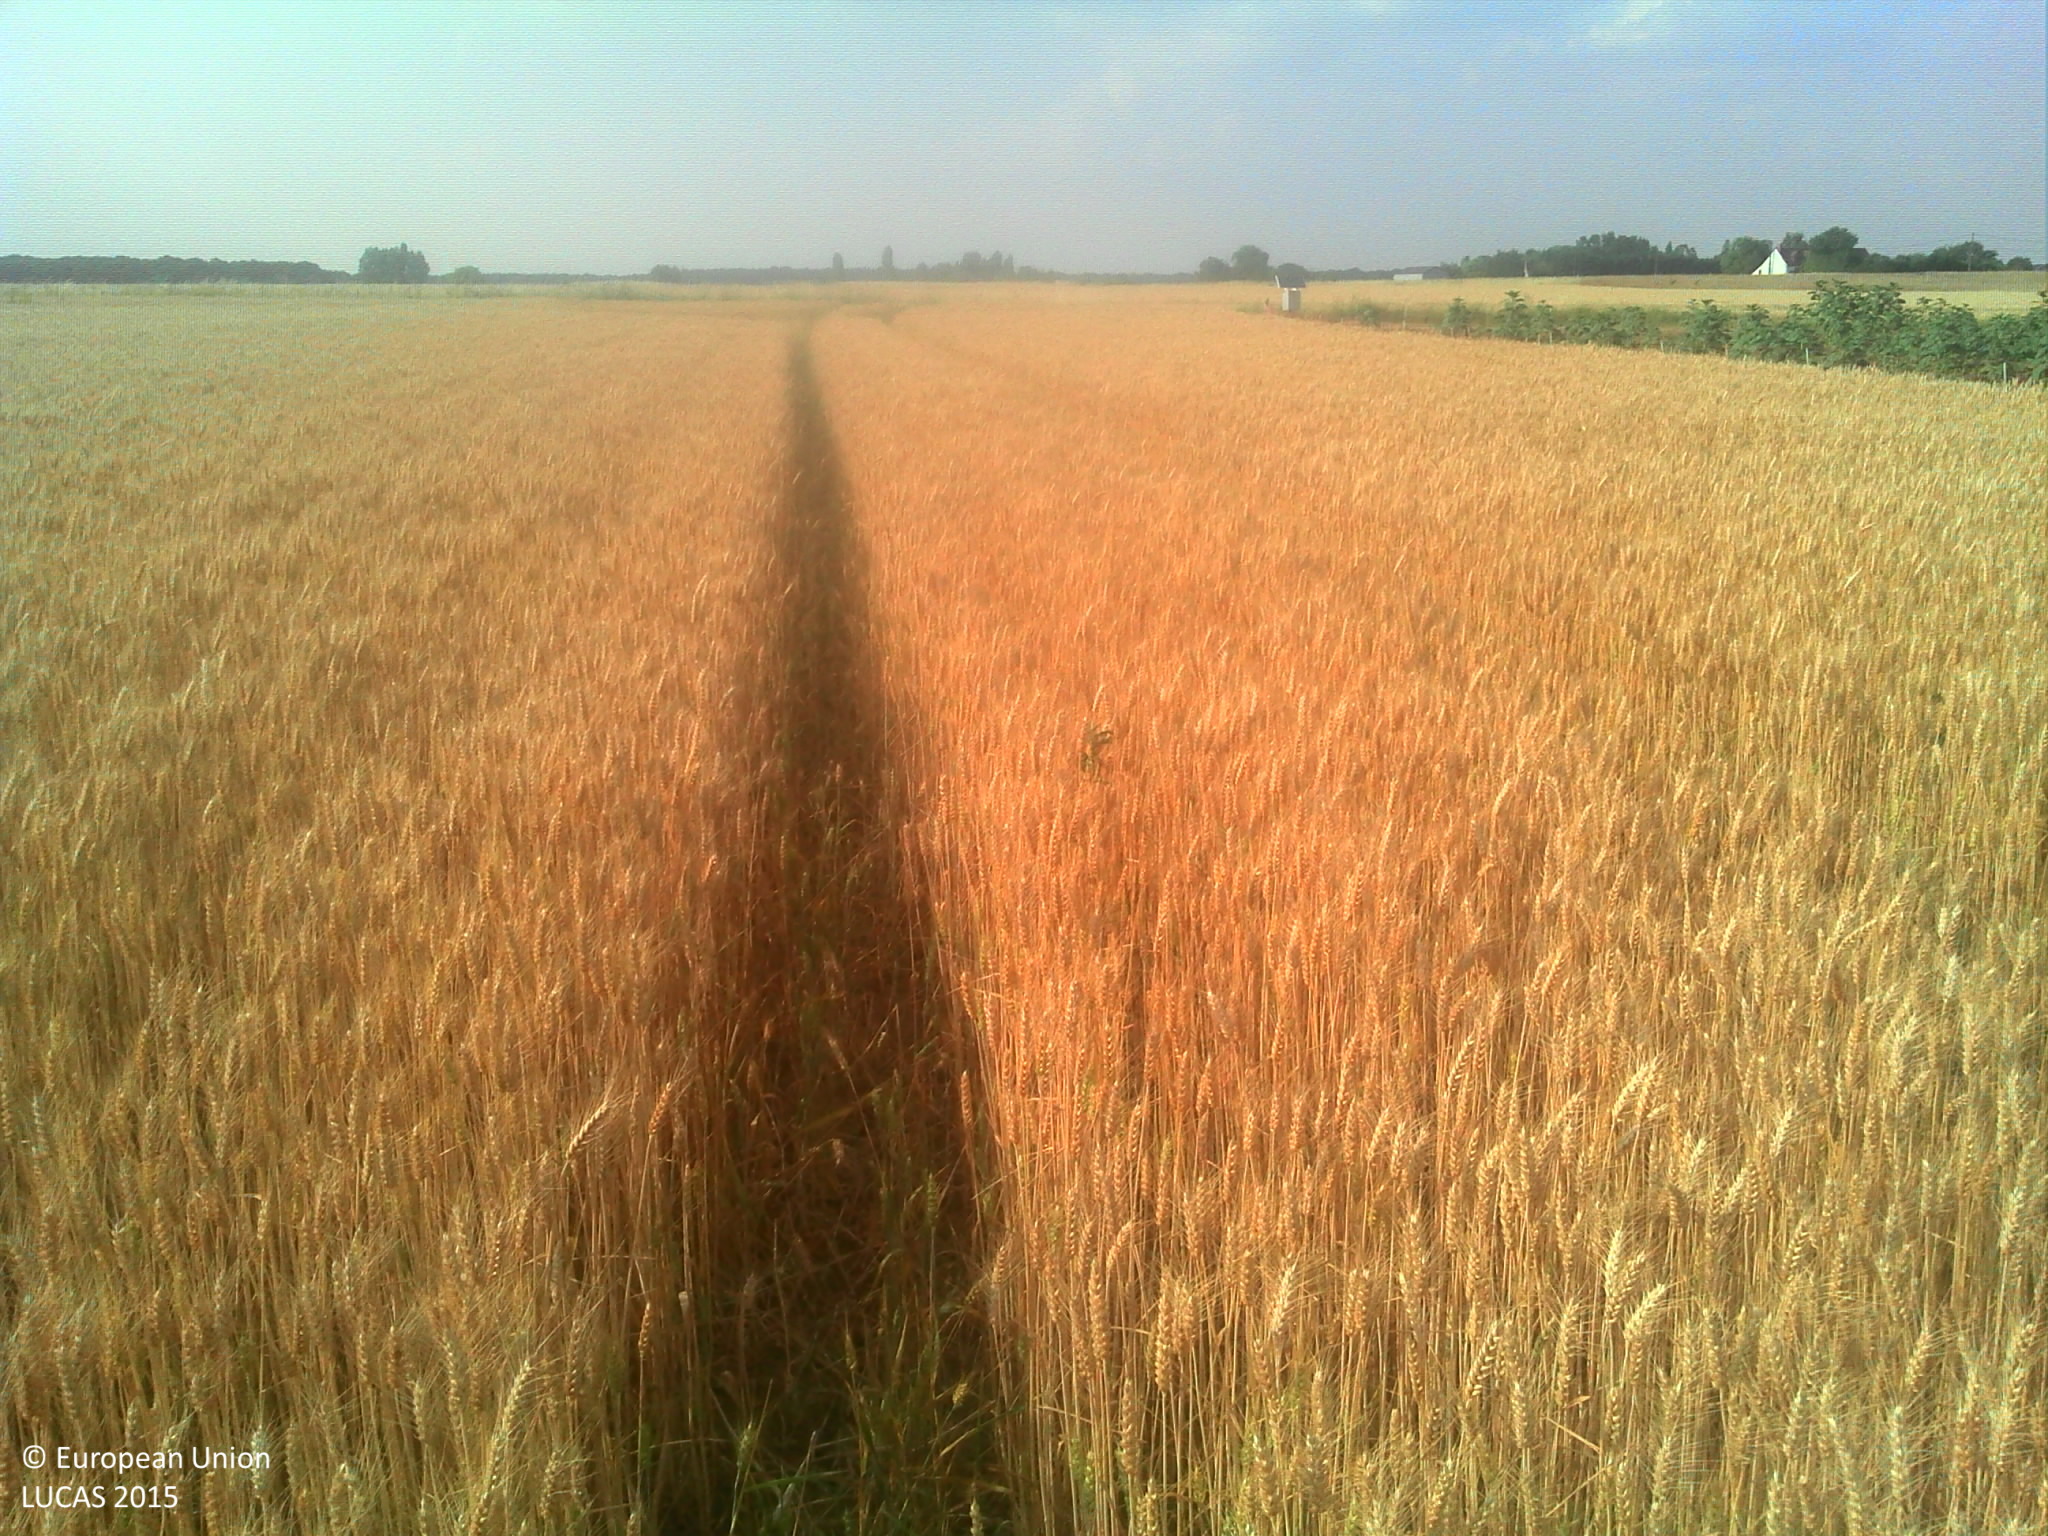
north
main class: Cropland
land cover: Durum wheat
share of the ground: > 75 %
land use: Agriculture (excluding fallow land and kitchen gardens)
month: July
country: FR
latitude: 47.6439
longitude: 1.0772
